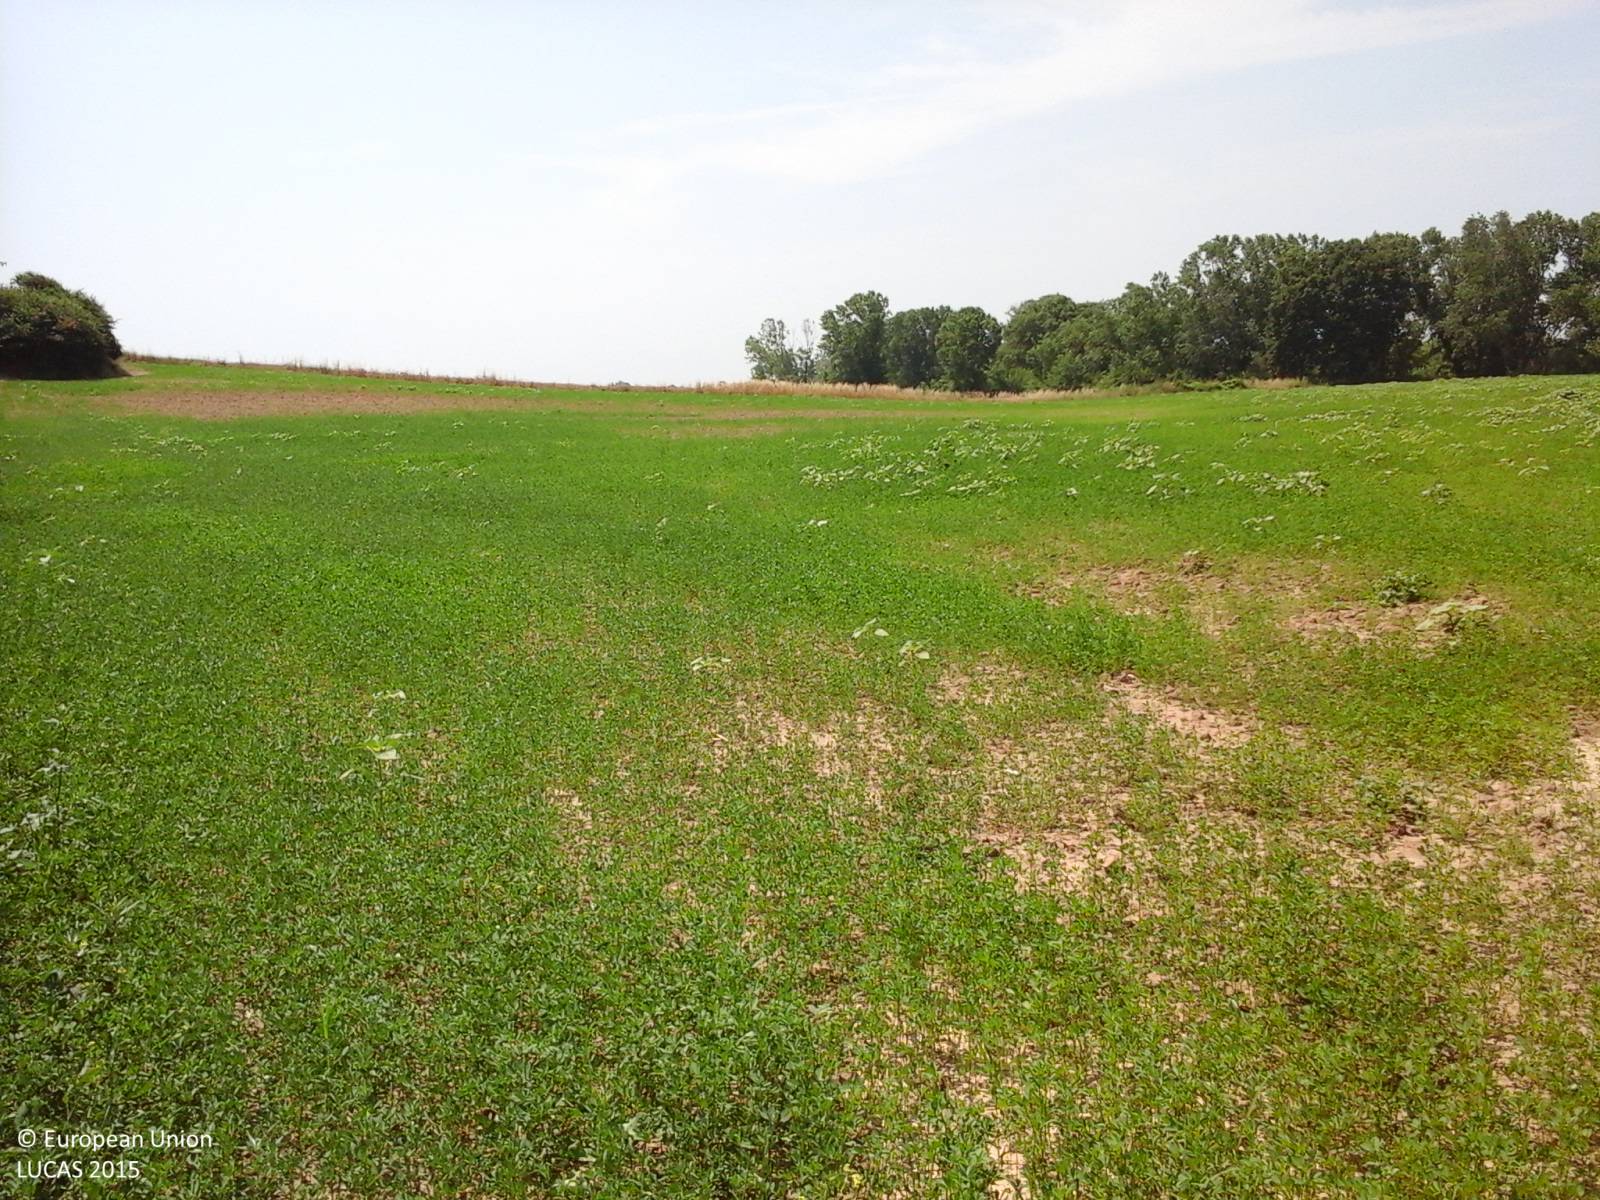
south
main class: Cropland
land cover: Lucerne
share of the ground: 50 - 75 %
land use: Agriculture (excluding fallow land and kitchen gardens)
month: June
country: IT
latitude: 42.3526
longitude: 11.5848
